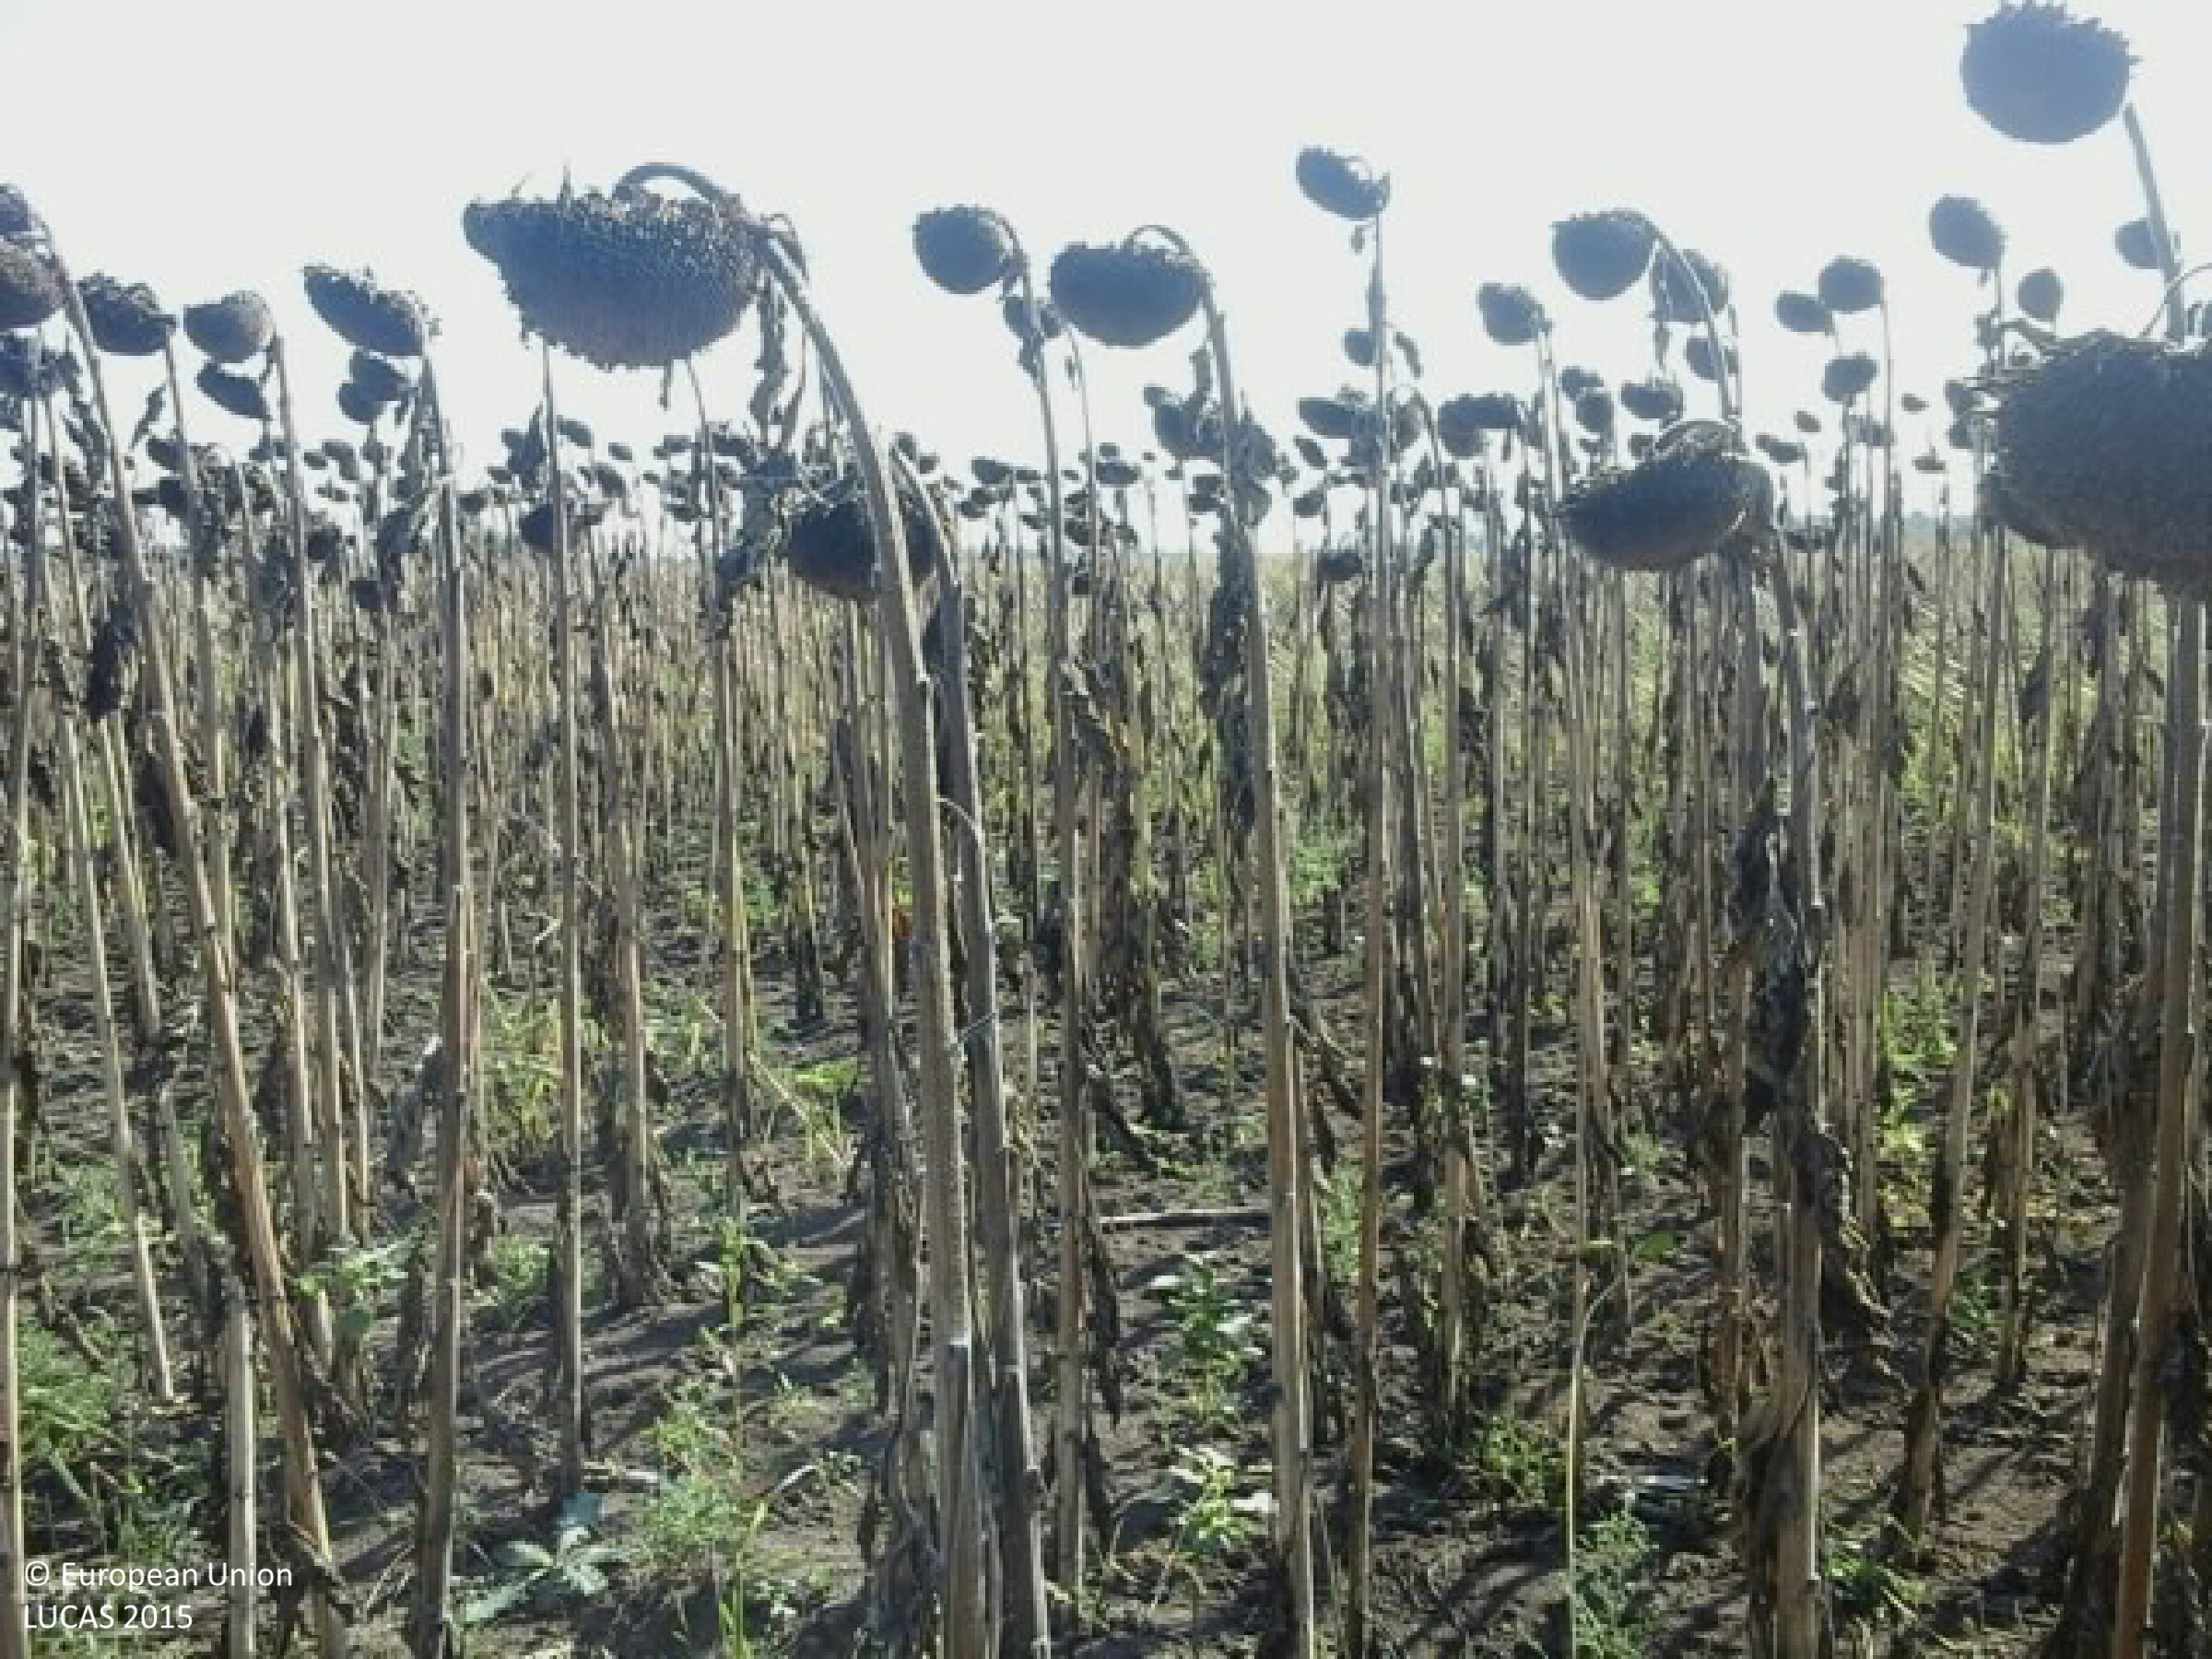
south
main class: Cropland
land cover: Sunflower
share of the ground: > 75 %
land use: Agriculture (excluding fallow land and kitchen gardens)
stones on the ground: < 10 %
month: September
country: HU
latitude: 47.6426
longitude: 19.7816
